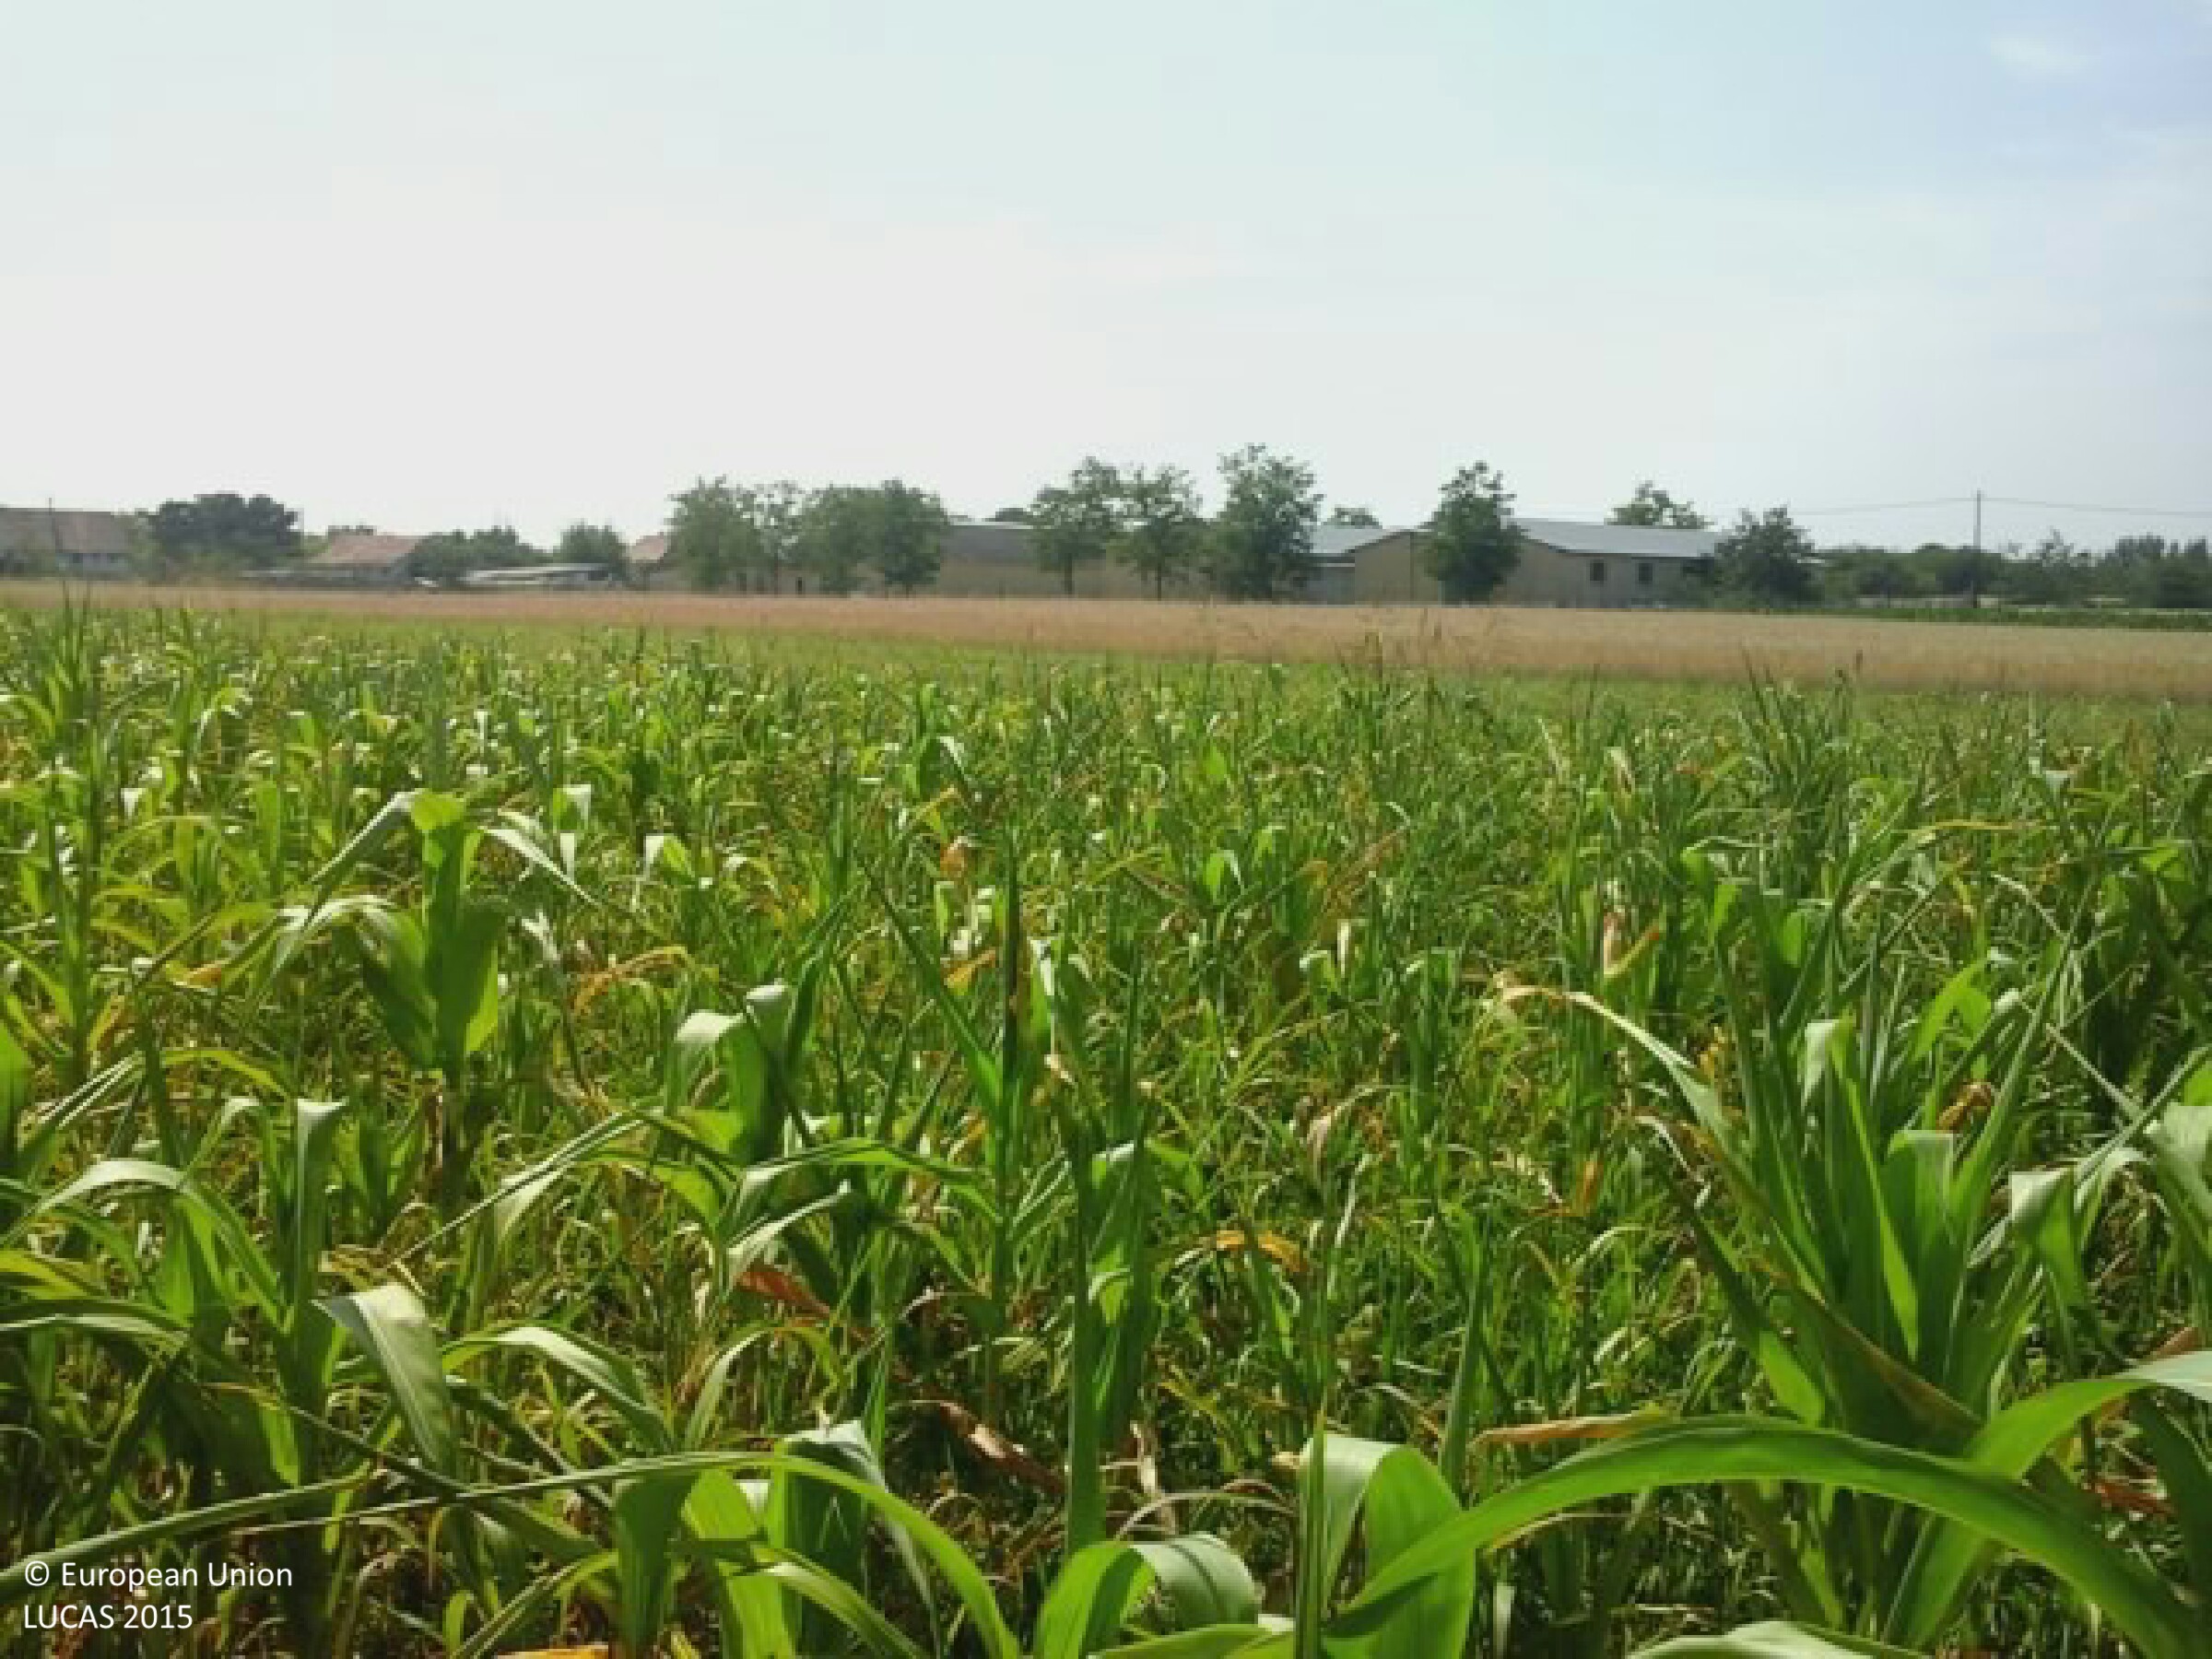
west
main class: Cropland
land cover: Maize
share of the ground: 50 - 75 %
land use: Agriculture (excluding fallow land and kitchen gardens)
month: July
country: HU
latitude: 47.2315
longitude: 19.0912
